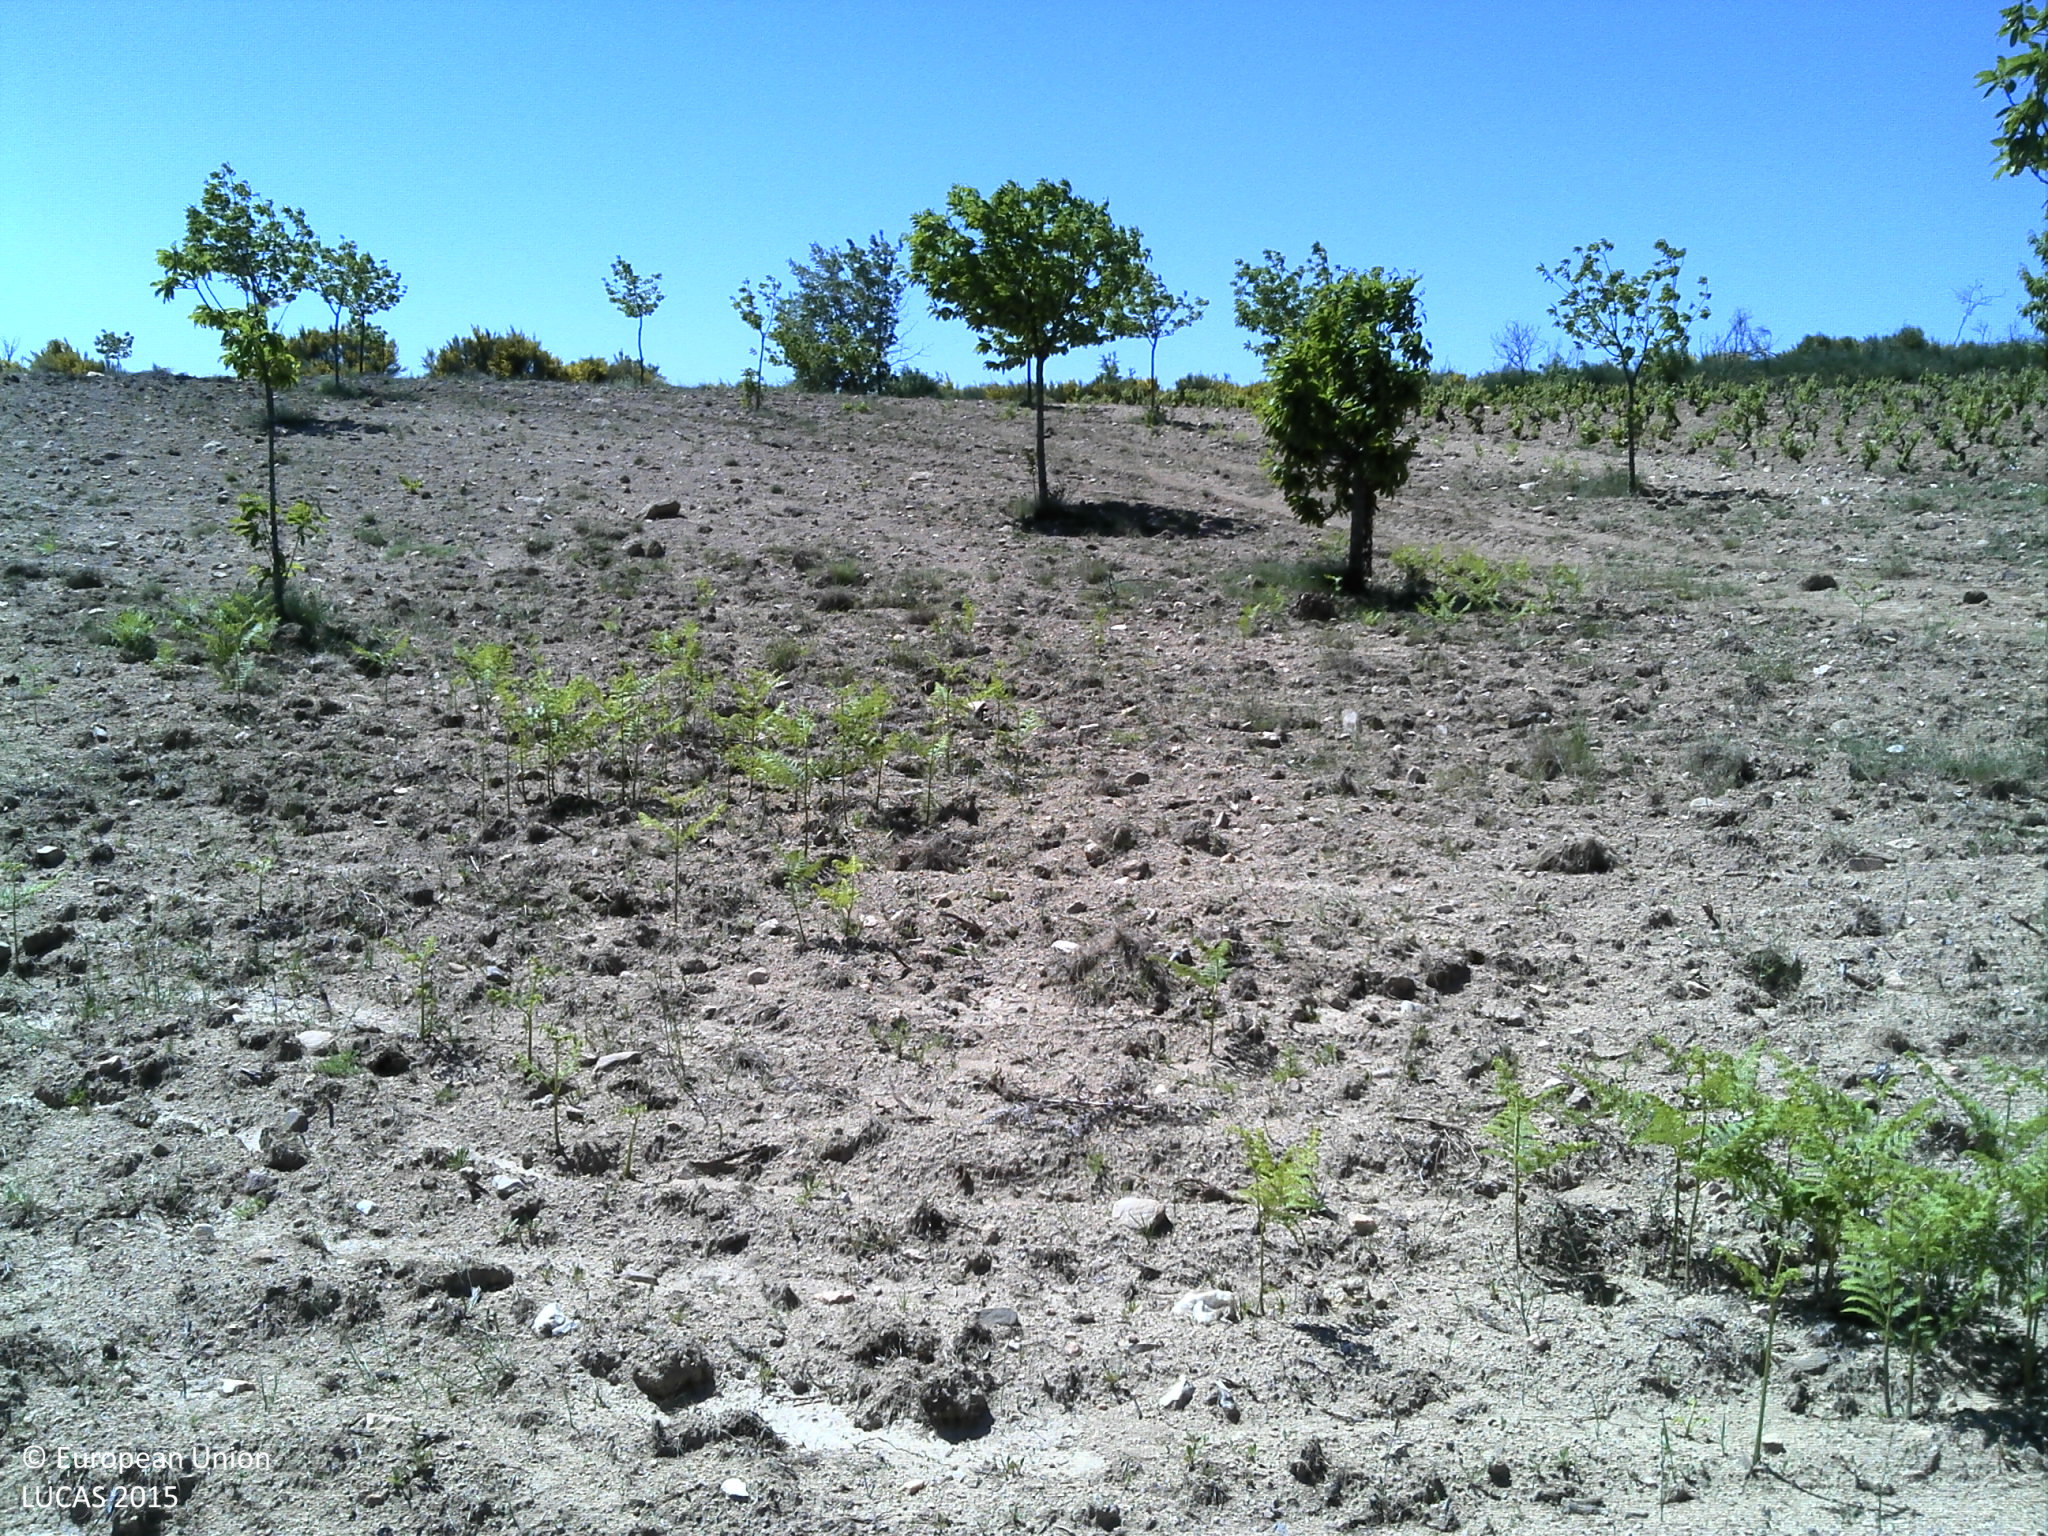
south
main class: Cropland
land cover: Nuts trees
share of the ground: < 10 %
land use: Agriculture (excluding fallow land and kitchen gardens)
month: May
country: PT
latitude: 41.7361
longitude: -7.3317
